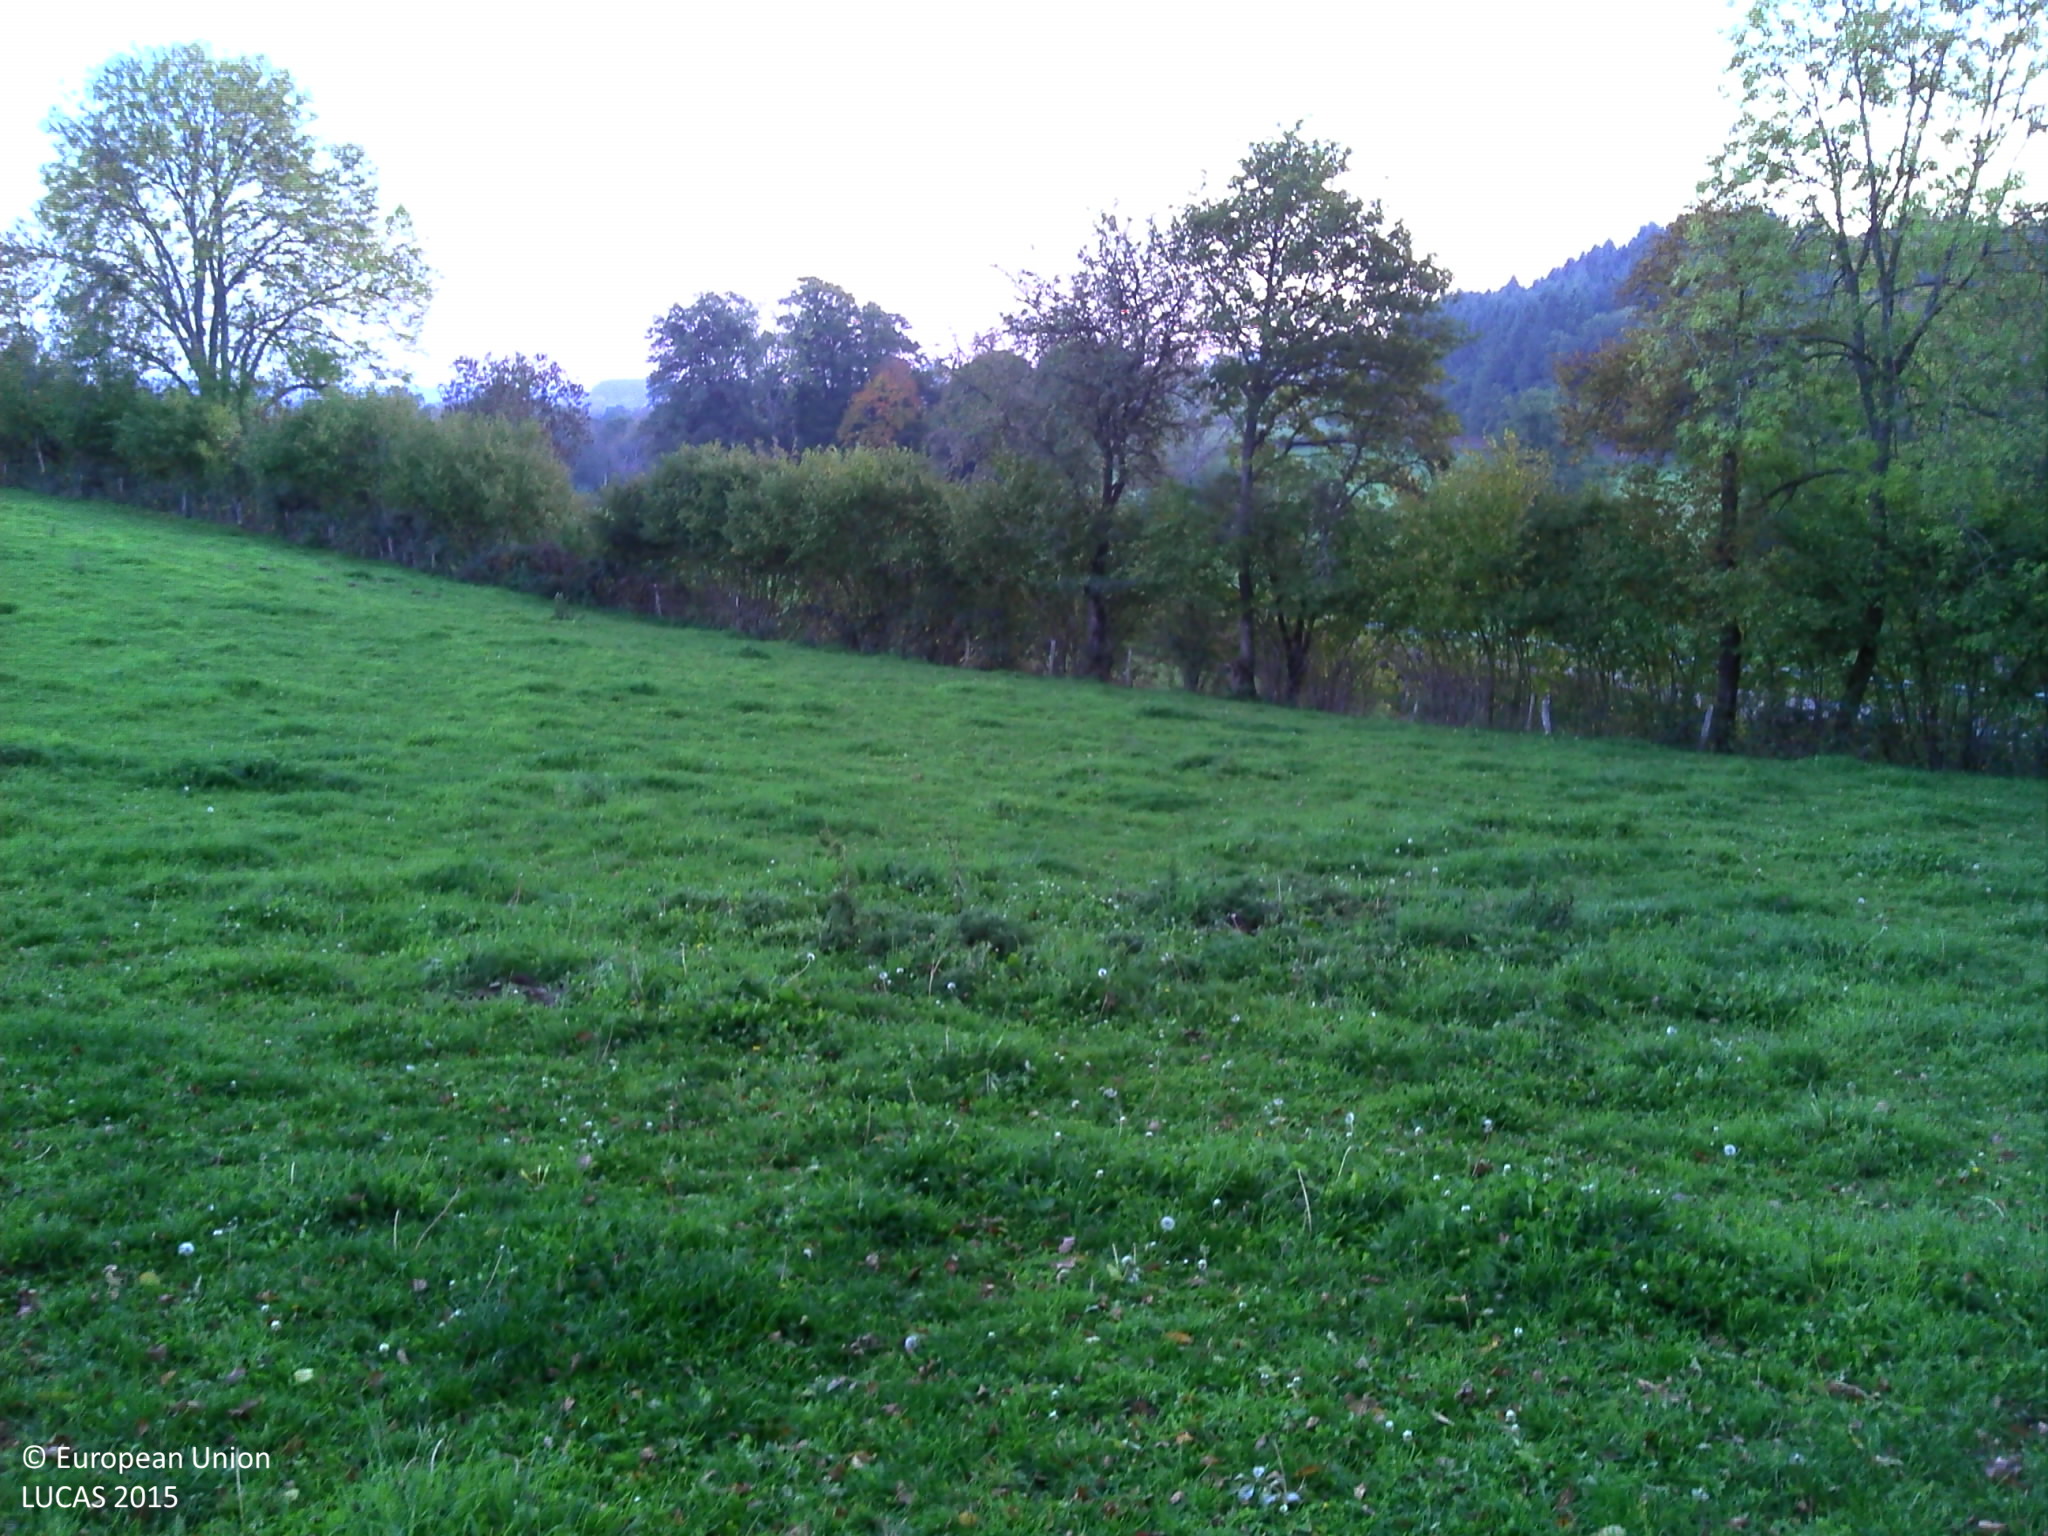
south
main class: Grassland
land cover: Grassland without tree/shrub cover
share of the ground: > 75 %
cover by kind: herbaceous plants 100 %
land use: Agriculture (excluding fallow land and kitchen gardens)
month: October
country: FR
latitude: 46.0703
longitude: 2.7704
